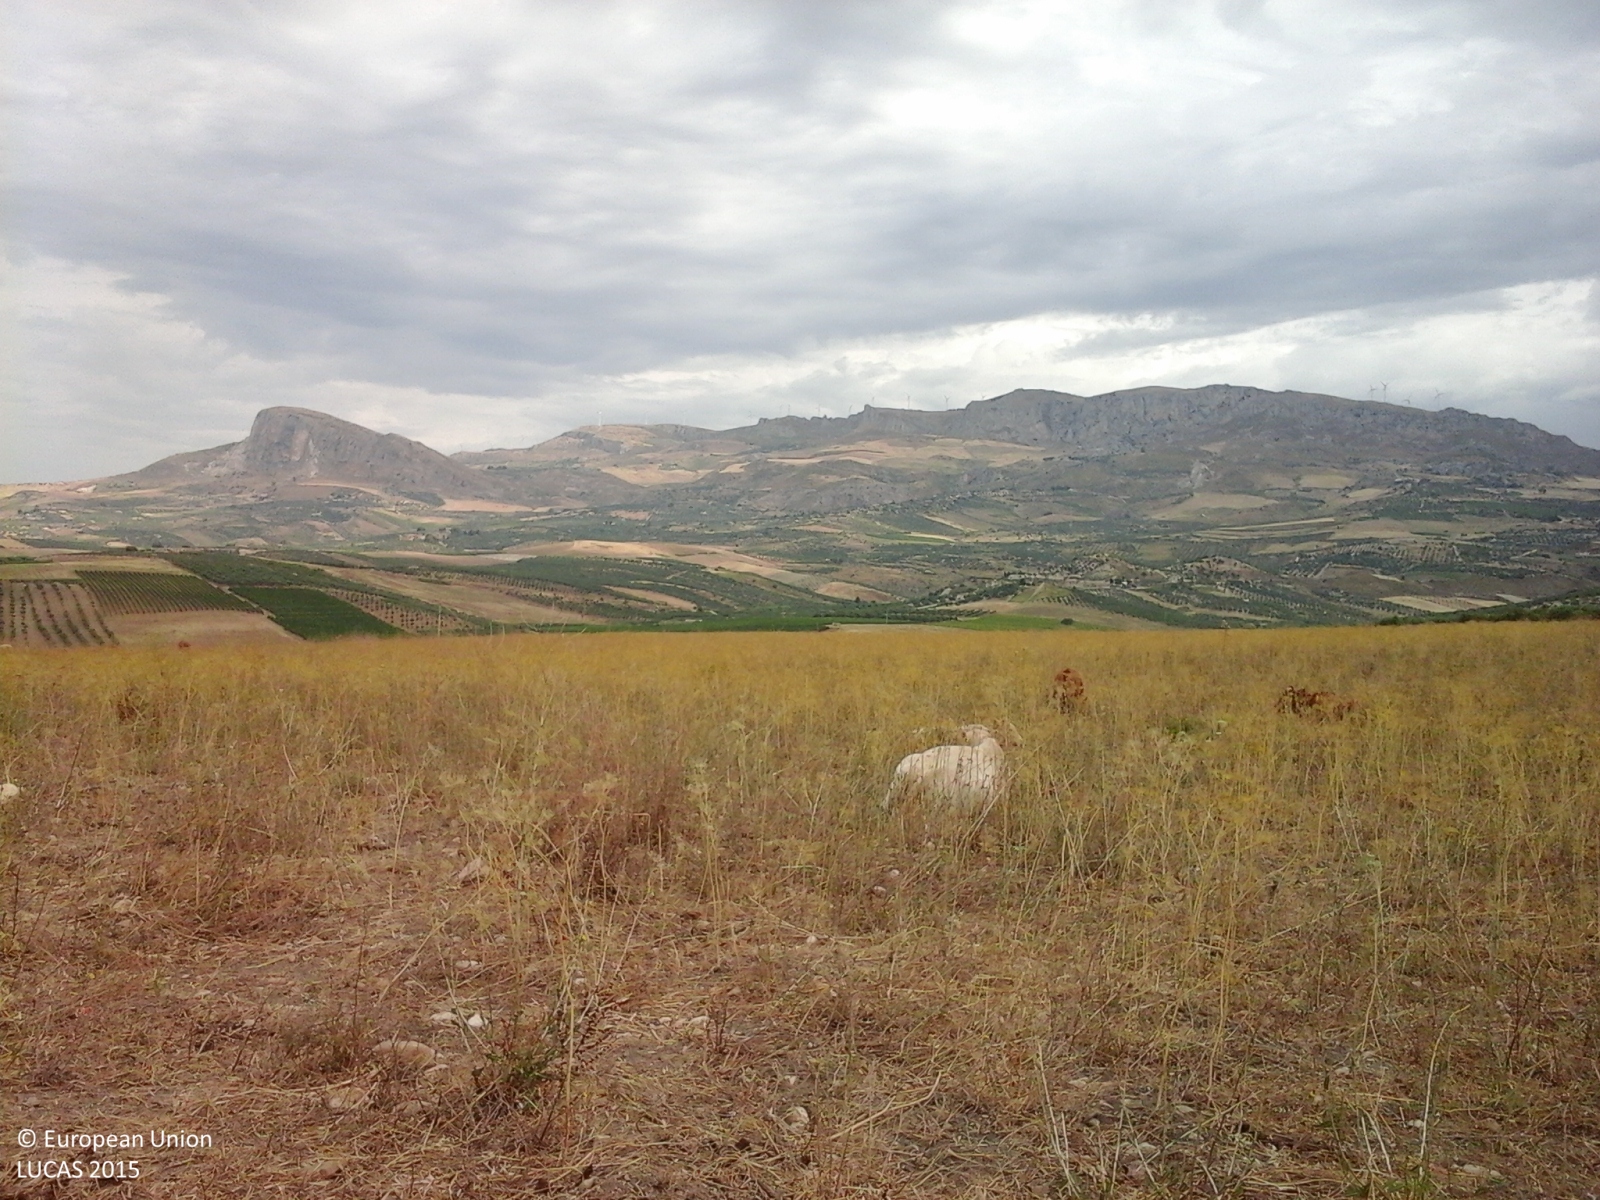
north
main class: Cropland
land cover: Durum wheat
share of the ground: > 75 %
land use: Agriculture (excluding fallow land and kitchen gardens)
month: June
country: IT
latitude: 37.5317
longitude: 13.1557
